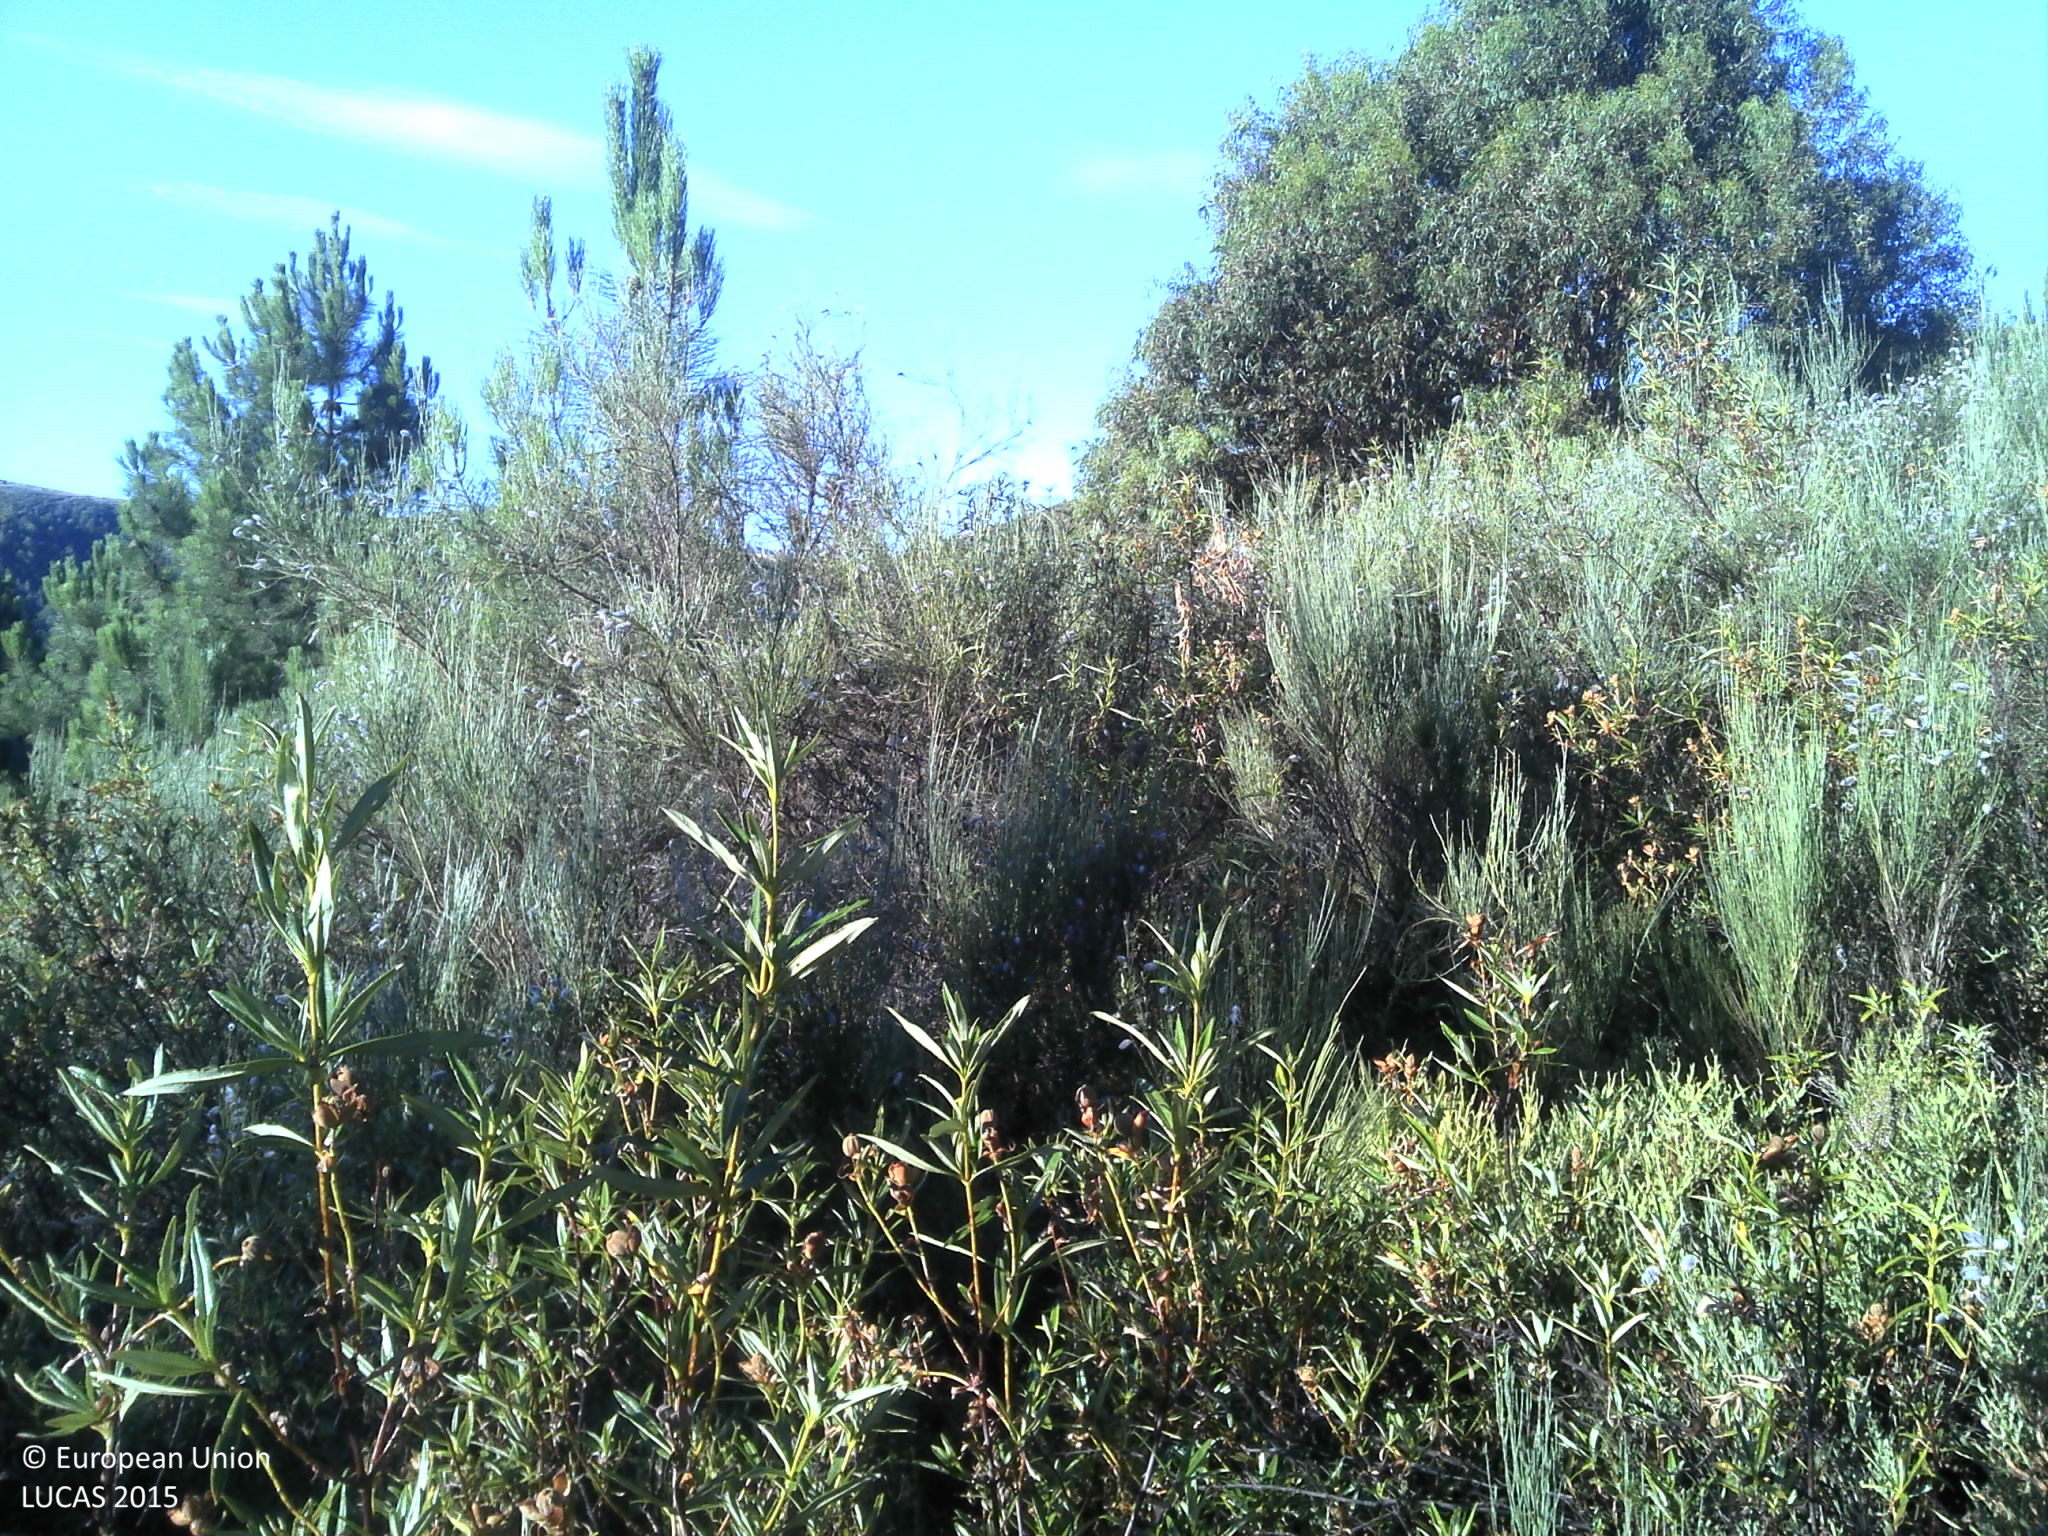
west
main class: Shrubland
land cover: Shrubland without tree cover
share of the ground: 50 - 75 %
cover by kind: shrubs 65 %, unconsolidated bare surface 35 %
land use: Forestry
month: July
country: PT
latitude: 40.0943
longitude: -7.6430
